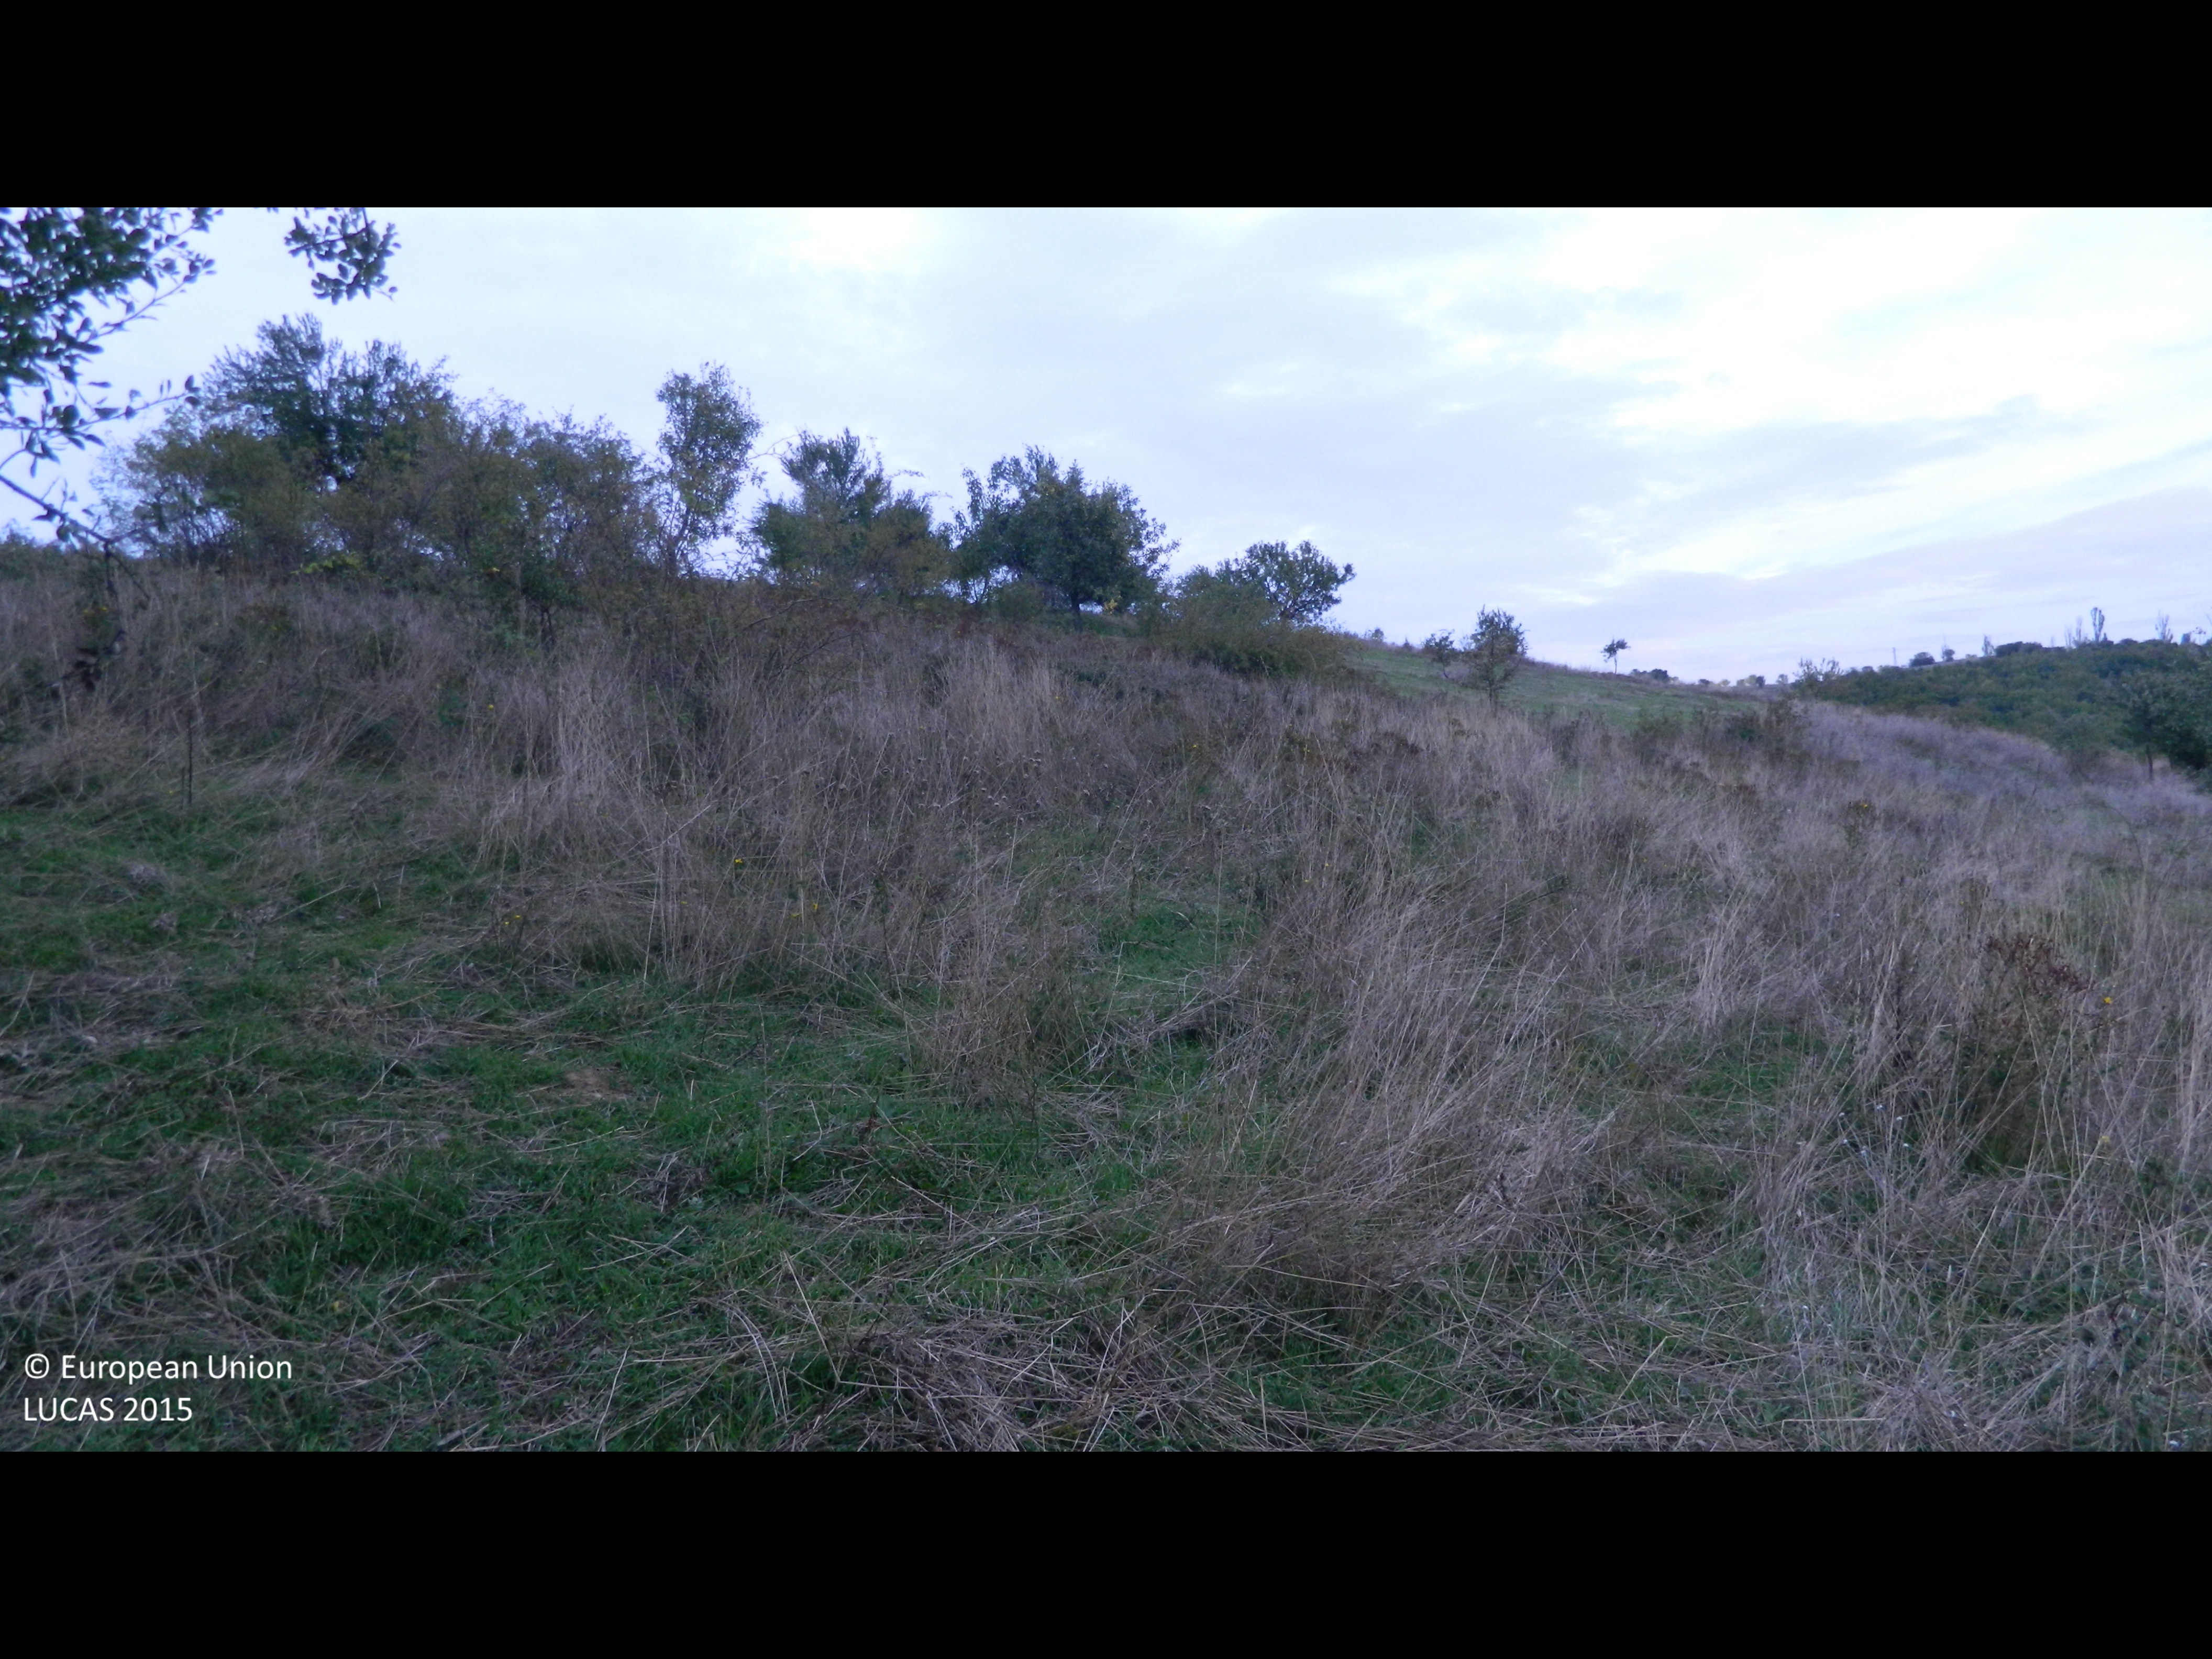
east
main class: Grassland
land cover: Grassland with sparse tree/shrub cover
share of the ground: > 75 %
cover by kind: herbaceous plants 85 %, shrubs 10 %, broadleaved forest trees 5 %
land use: Agriculture (excluding fallow land and kitchen gardens)
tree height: > 5 m
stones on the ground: < 10 %
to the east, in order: Grassland with sparse tree/shrub cover; Shrubland with sparse tree cover; Grassland without tree/shrub cover; Single bushes/trees; Grassland without tree/shrub cover; Tracks; Grassland without tree/shrub cover
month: October
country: BG
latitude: 41.8021
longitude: 25.2577
